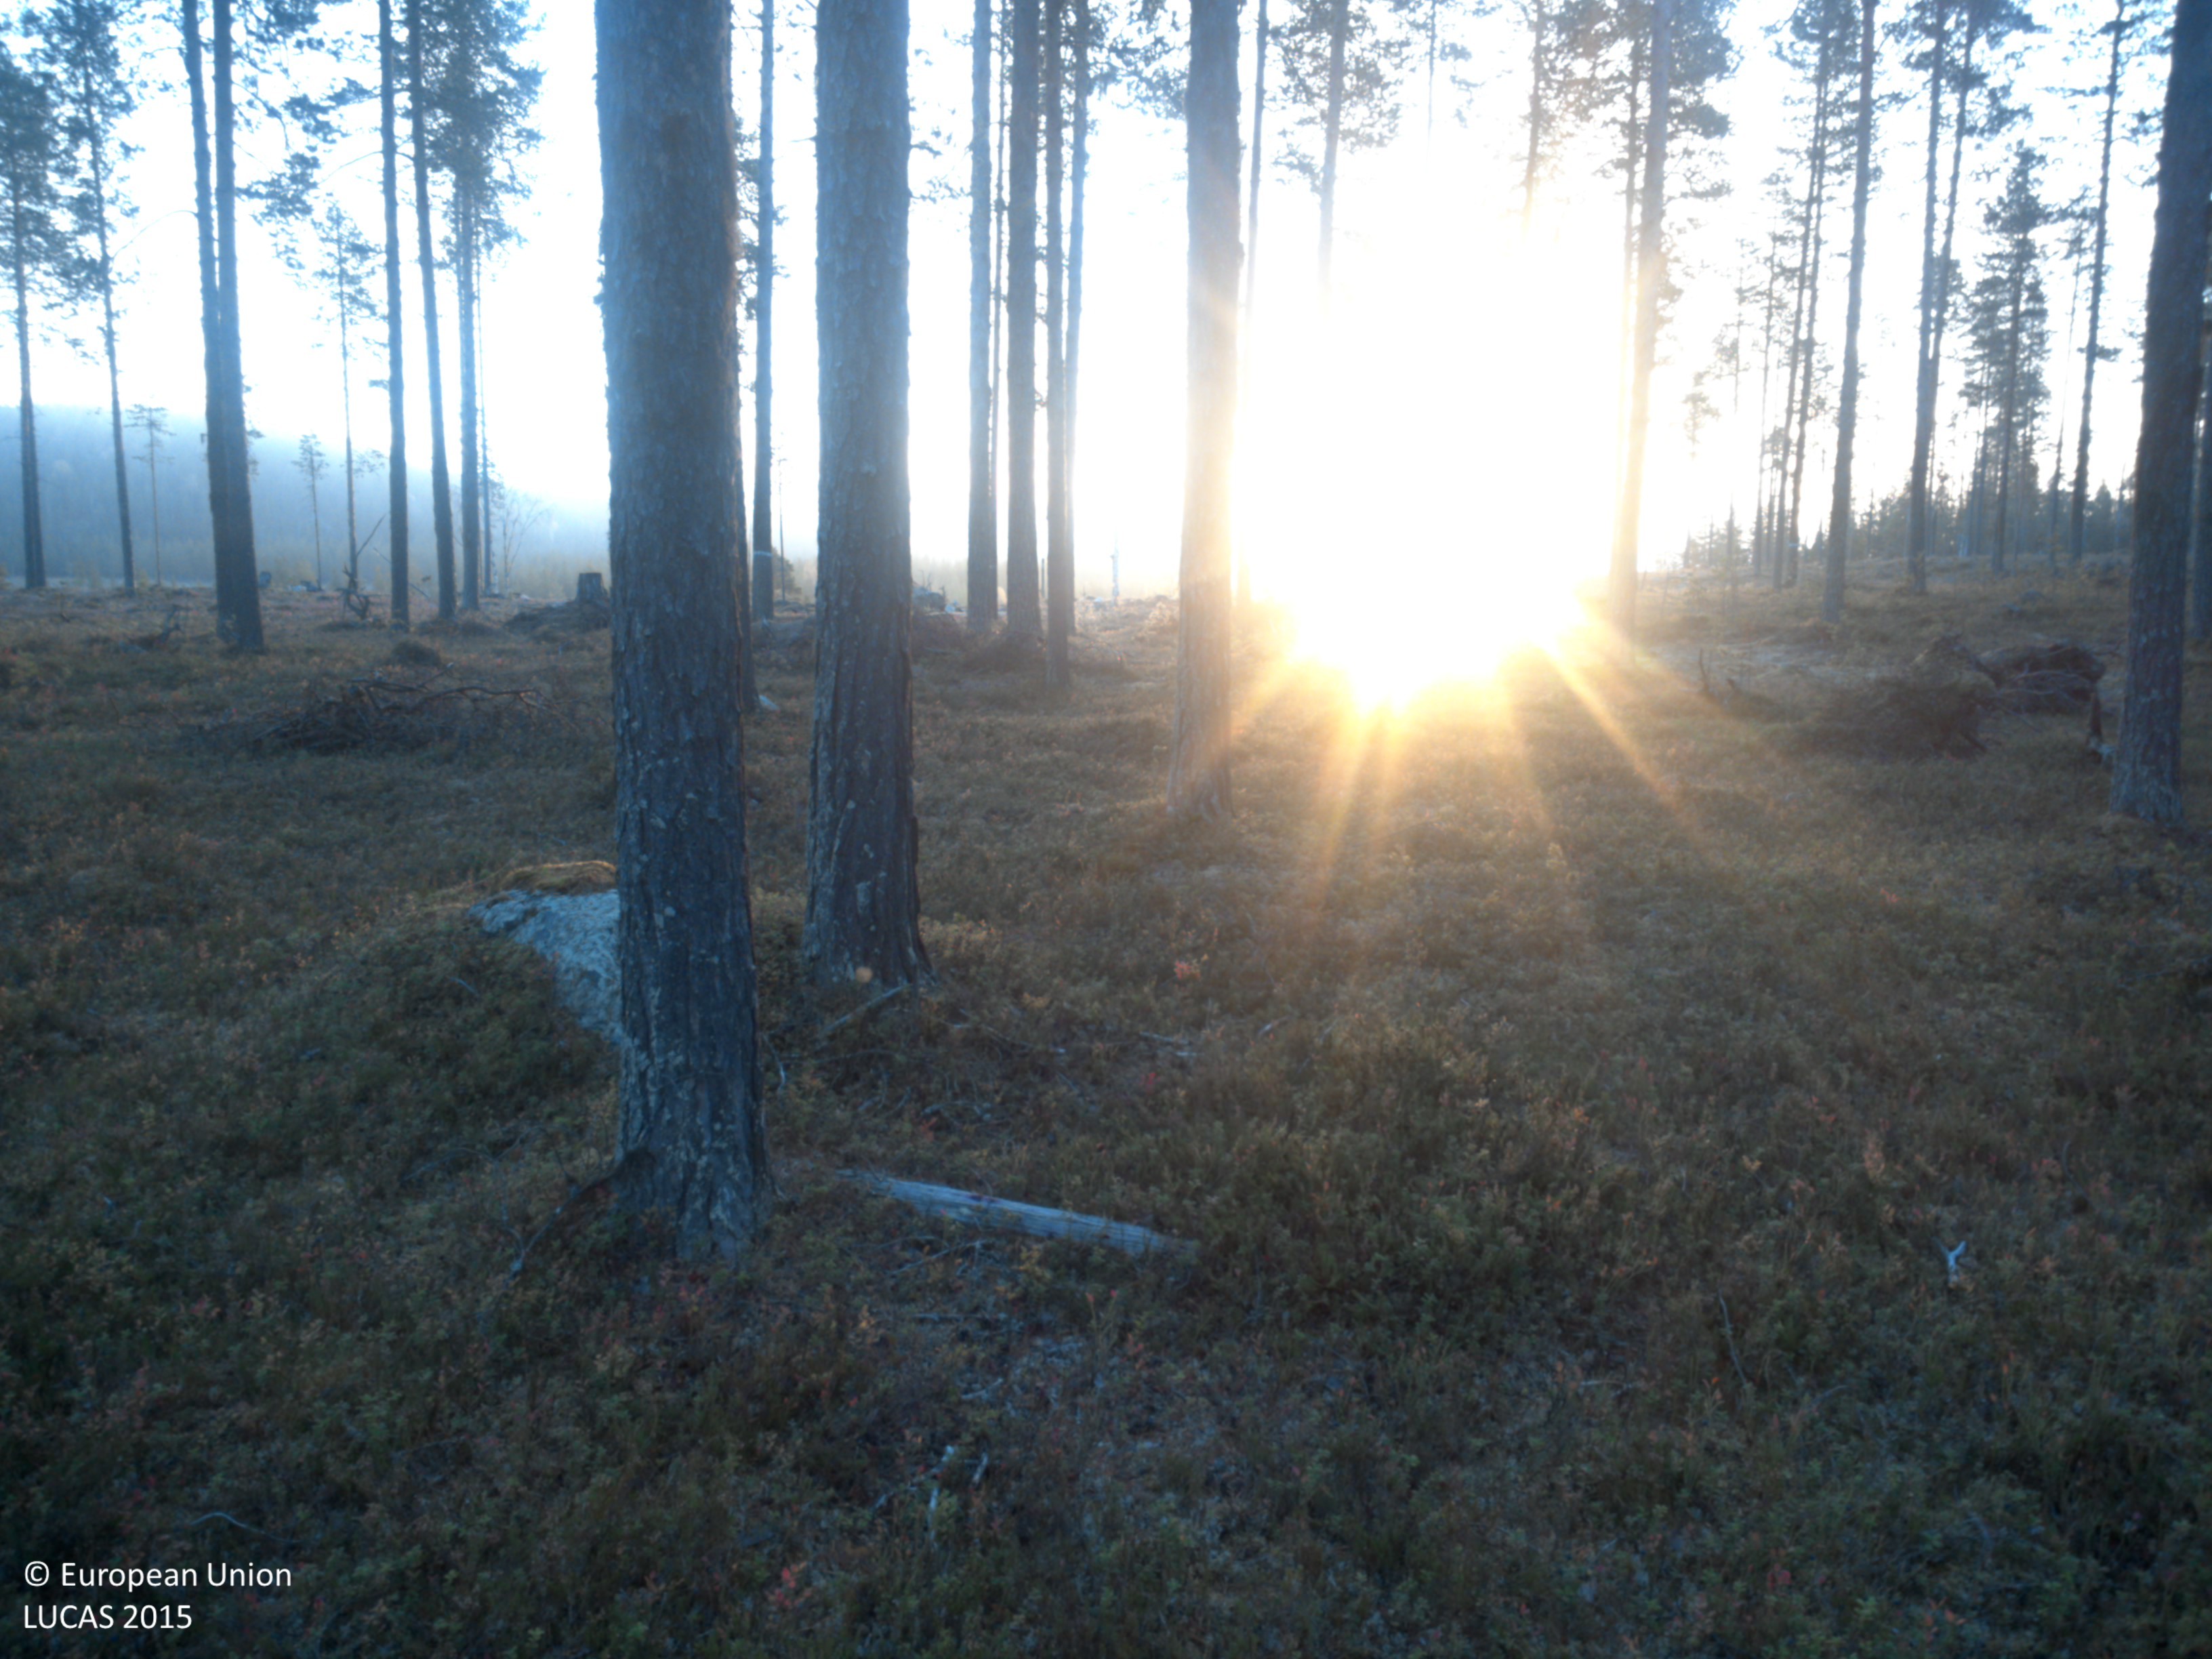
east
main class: Woodland
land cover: Pine dominated coniferous woodland
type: boreal forest
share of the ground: 25 - 50 %
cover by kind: coniferous forest trees 50 %, shrubs 25 %, lichens and mosses 15 %, herbaceous plants 10 %
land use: Forestry
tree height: > 5 m
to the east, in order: Pine dominated coniferous woodland; Tracks; Pine dominated coniferous woodland; Shrubland with sparse tree cover; Pine dominated mixed woodland; Inland fresh running water
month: October
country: SE
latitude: 64.7977
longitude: 18.3216
